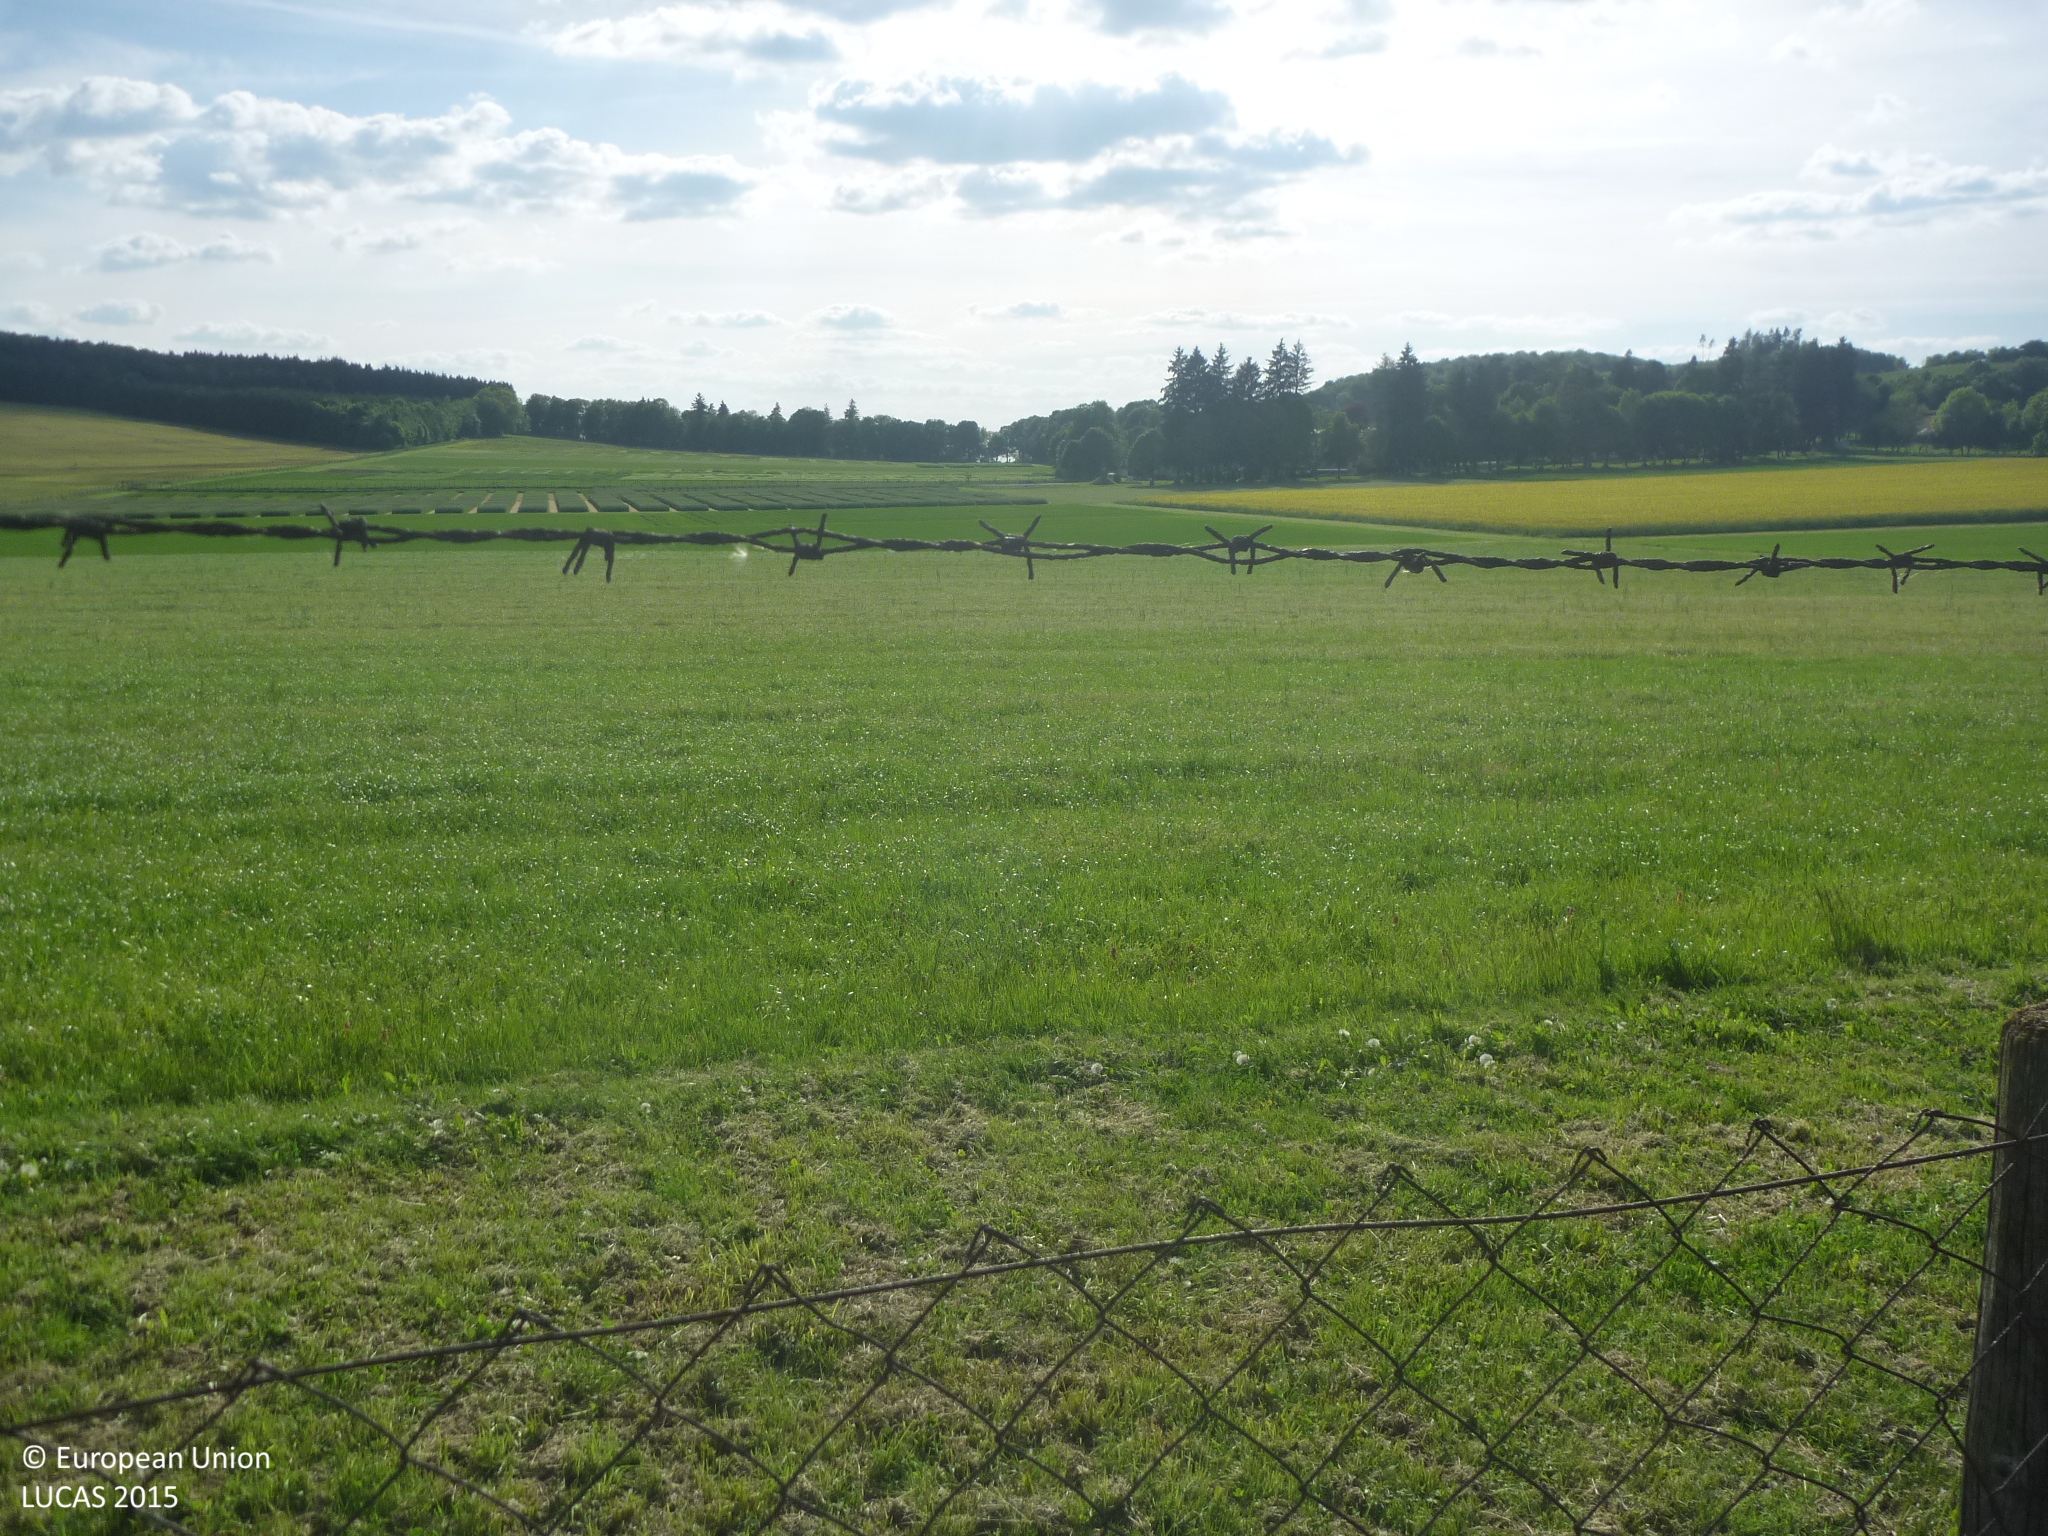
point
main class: Cropland
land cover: Temporary grasslands
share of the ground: > 75 %
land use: Agriculture (excluding fallow land and kitchen gardens)
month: May
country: DE
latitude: 48.4733
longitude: 9.3105
